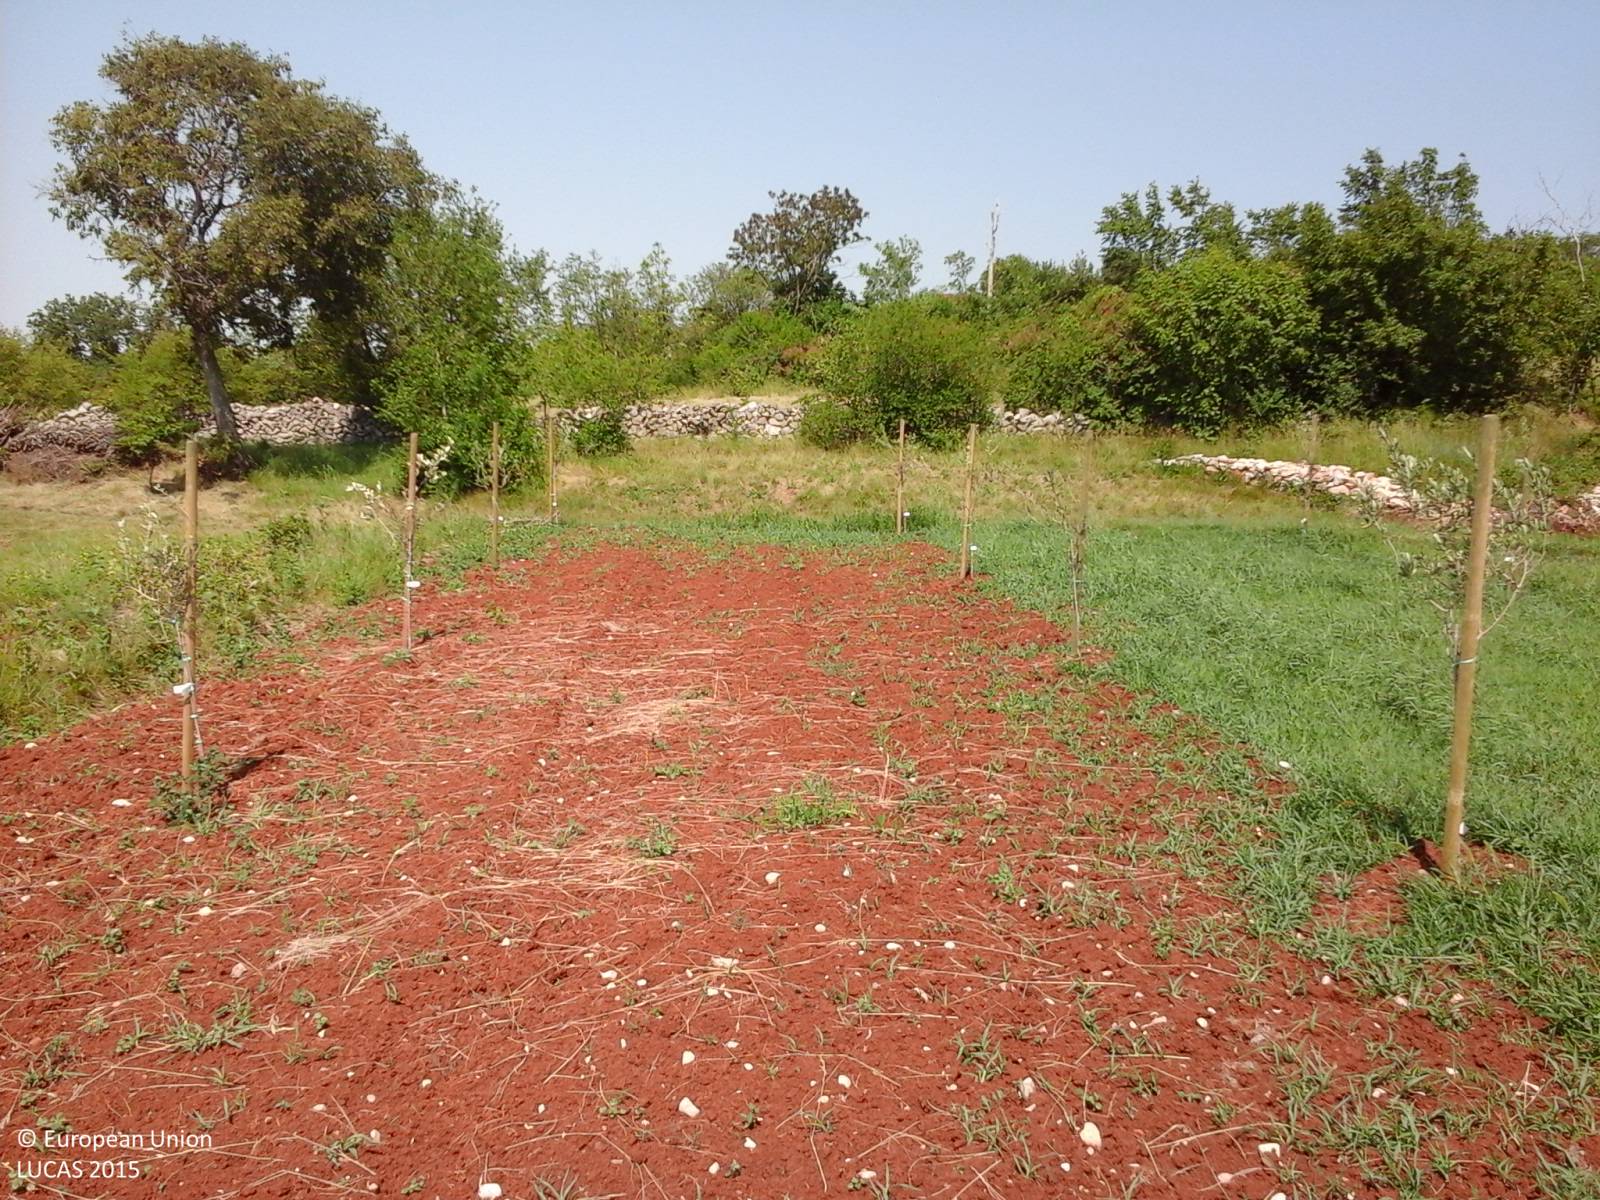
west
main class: Cropland
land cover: Olive groves
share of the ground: 25 - 50 %
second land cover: Grassland without tree/shrub cover
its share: 10 - 25 %
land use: Agriculture (excluding fallow land and kitchen gardens)
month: June
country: IT
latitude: 45.8780
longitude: 13.5392
